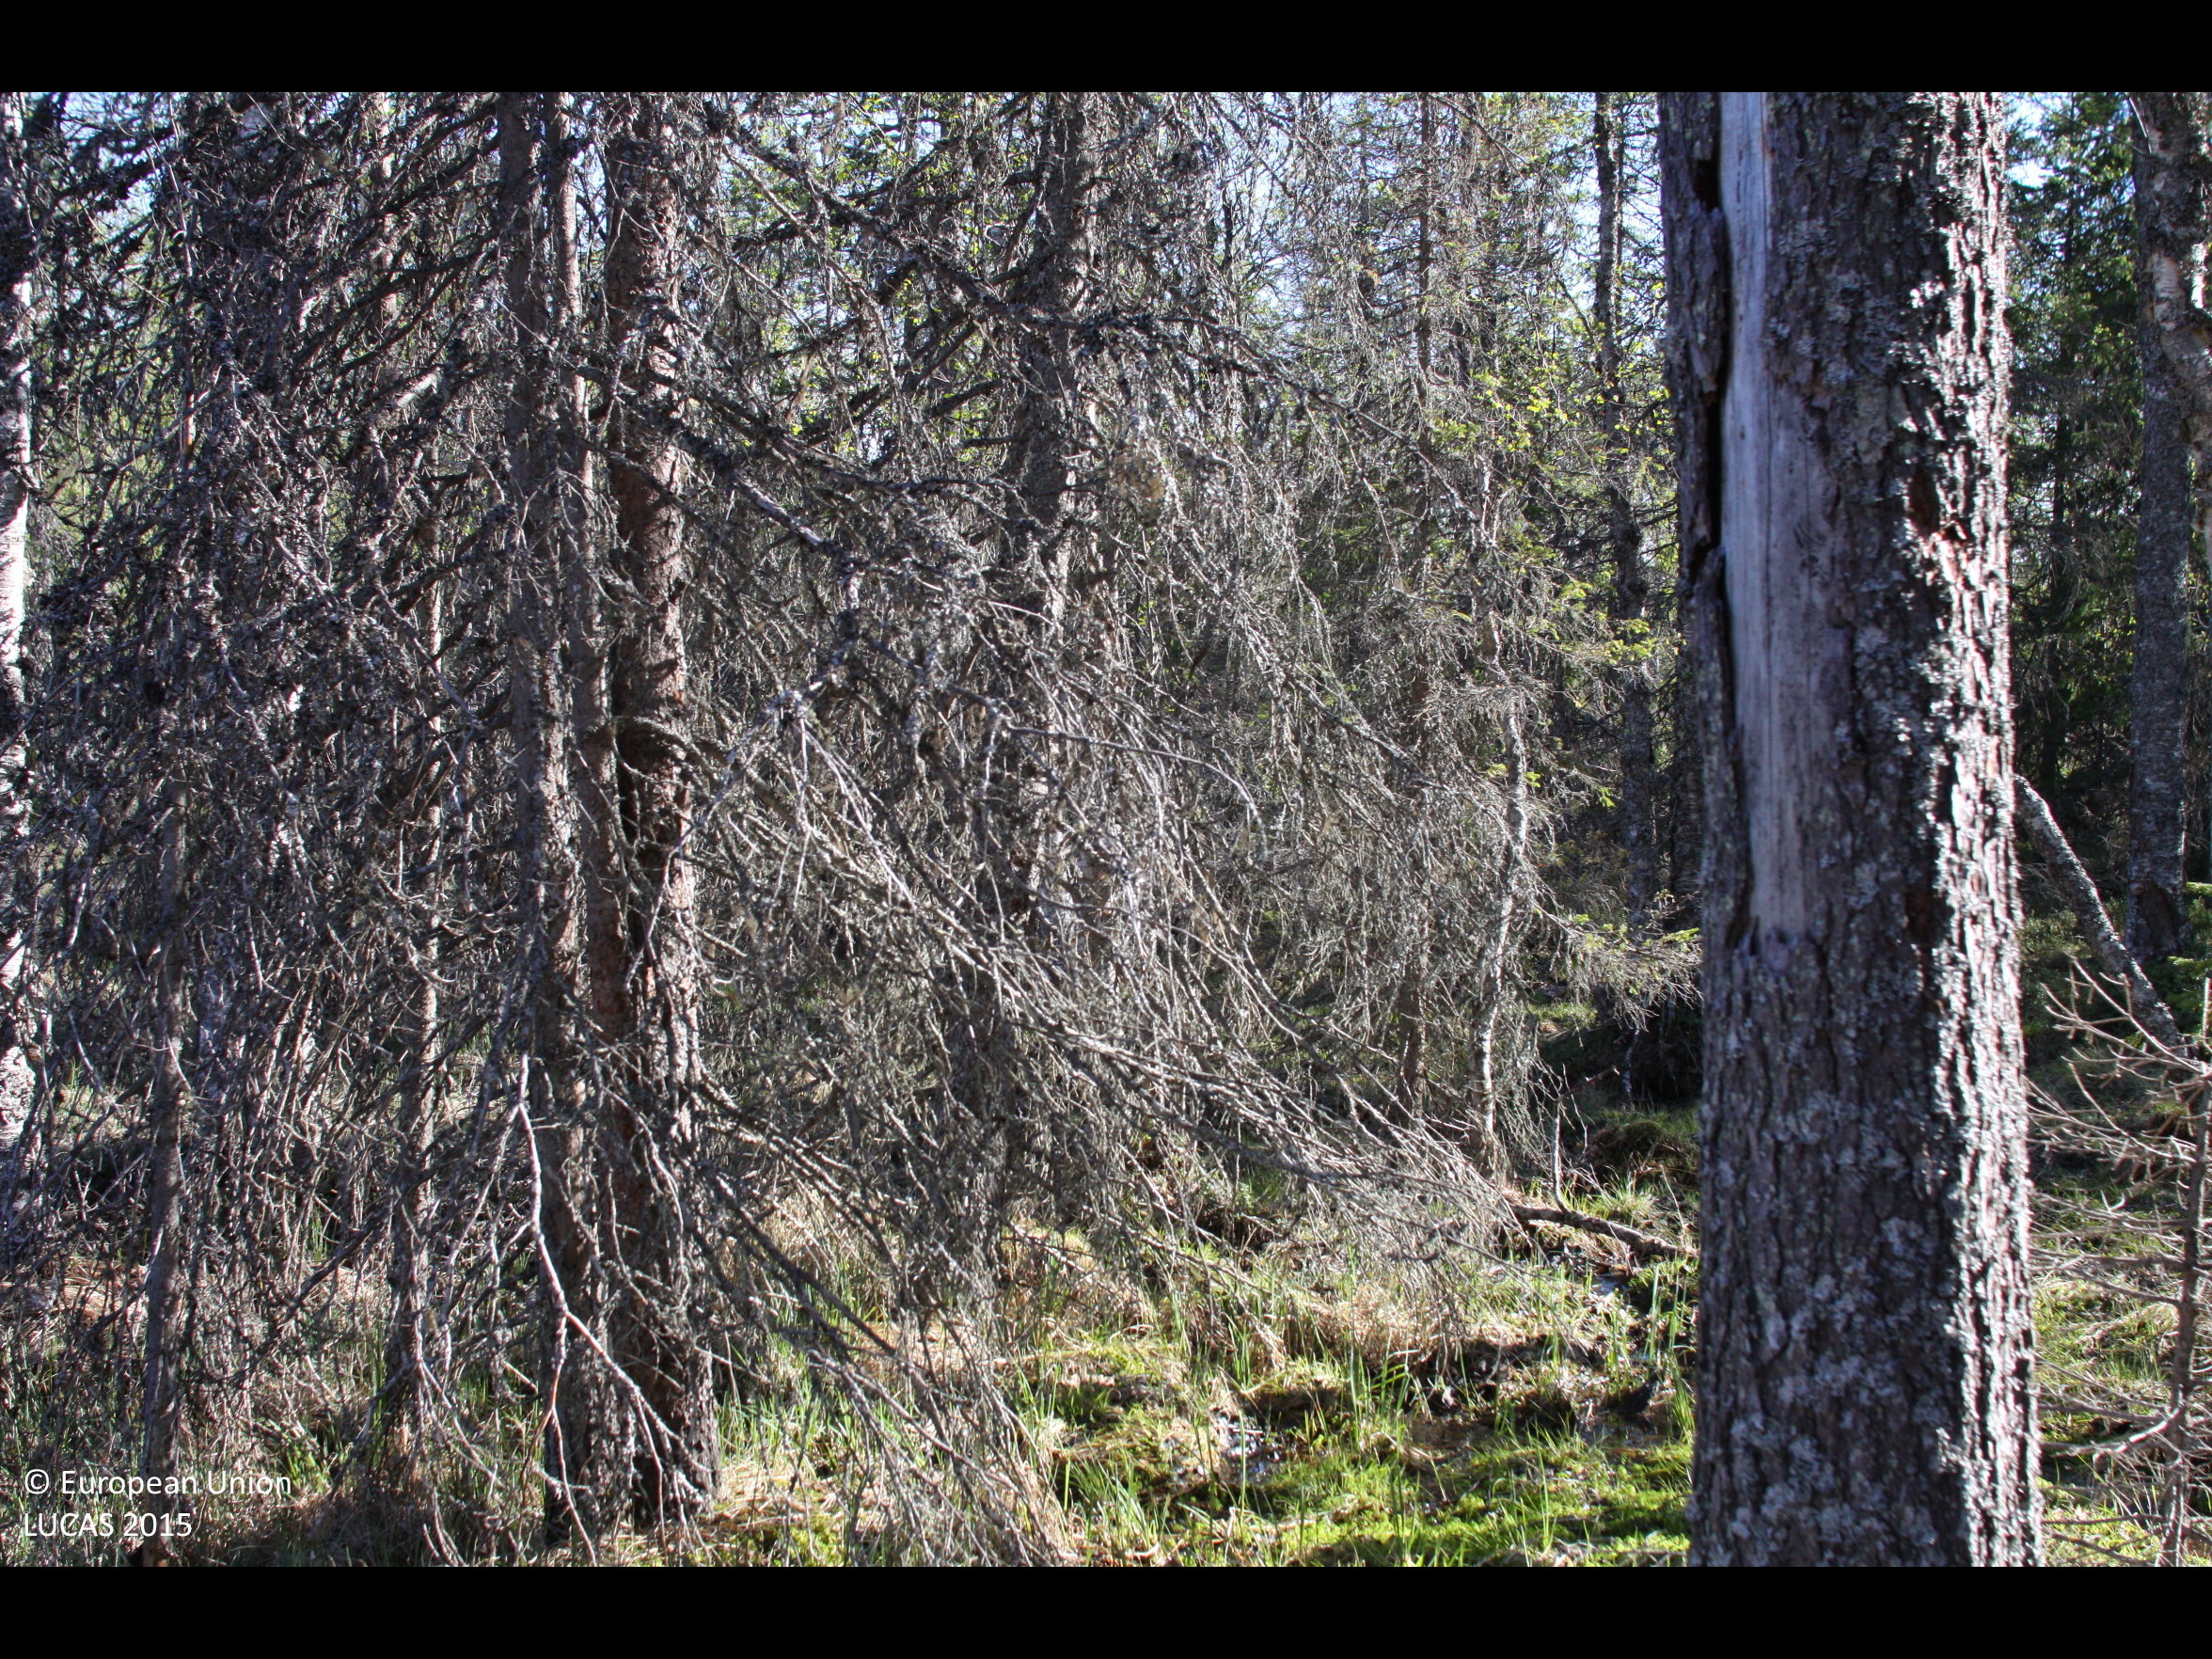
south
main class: Woodland
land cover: Spruce dominated mixed woodland
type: boreal forest
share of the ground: > 75 %
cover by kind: coniferous forest trees 45 %, broadleaved forest trees 35 %, herbaceous plants 10 %, lichens and mosses 10 %
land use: Forestry
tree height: > 5 m
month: June
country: FI
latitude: 66.2462
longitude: 27.4936
